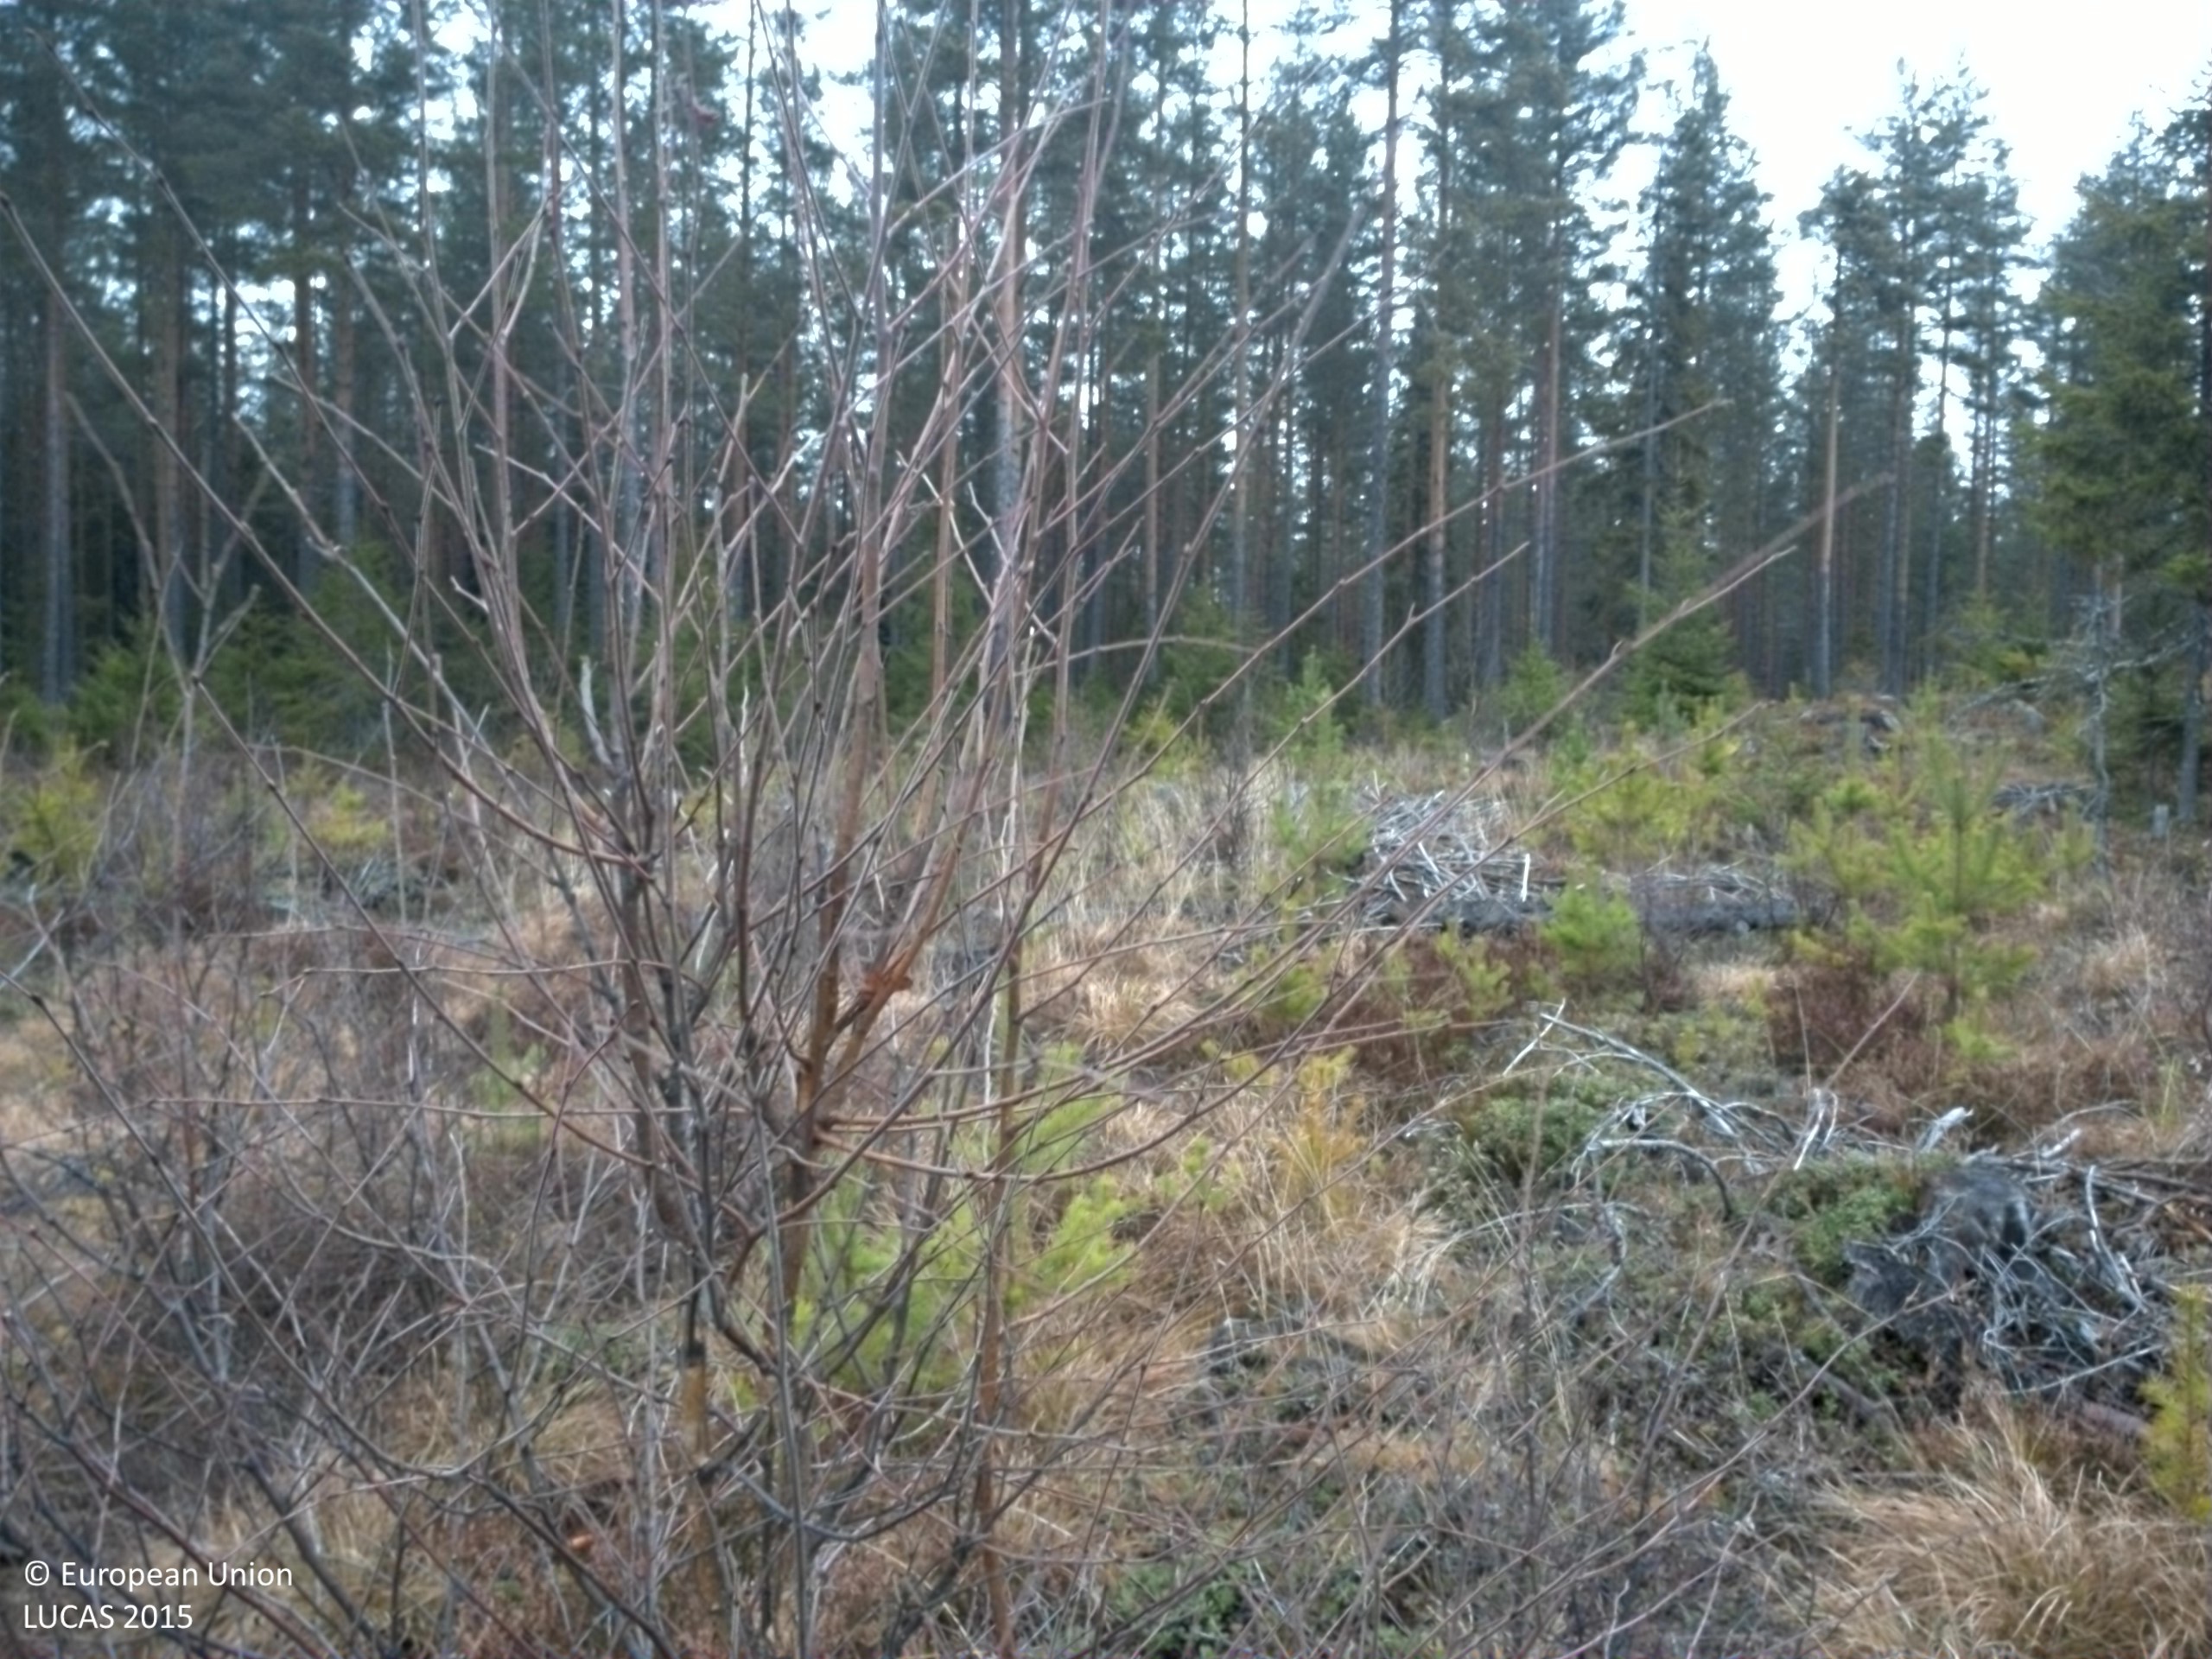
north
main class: Woodland
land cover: Pine dominated mixed woodland
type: boreal forest
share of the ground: 25 - 50 %
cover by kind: herbaceous plants 30 %, shrubs 25 %, coniferous forest trees 15 %, broadleaved forest trees 10 %, lichens and mosses 10 %, consolidated bare surface 5 %, unconsolidated bare surface 5 %
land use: Forestry
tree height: < 5 m
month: November
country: SE
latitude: 61.5854
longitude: 16.8979
